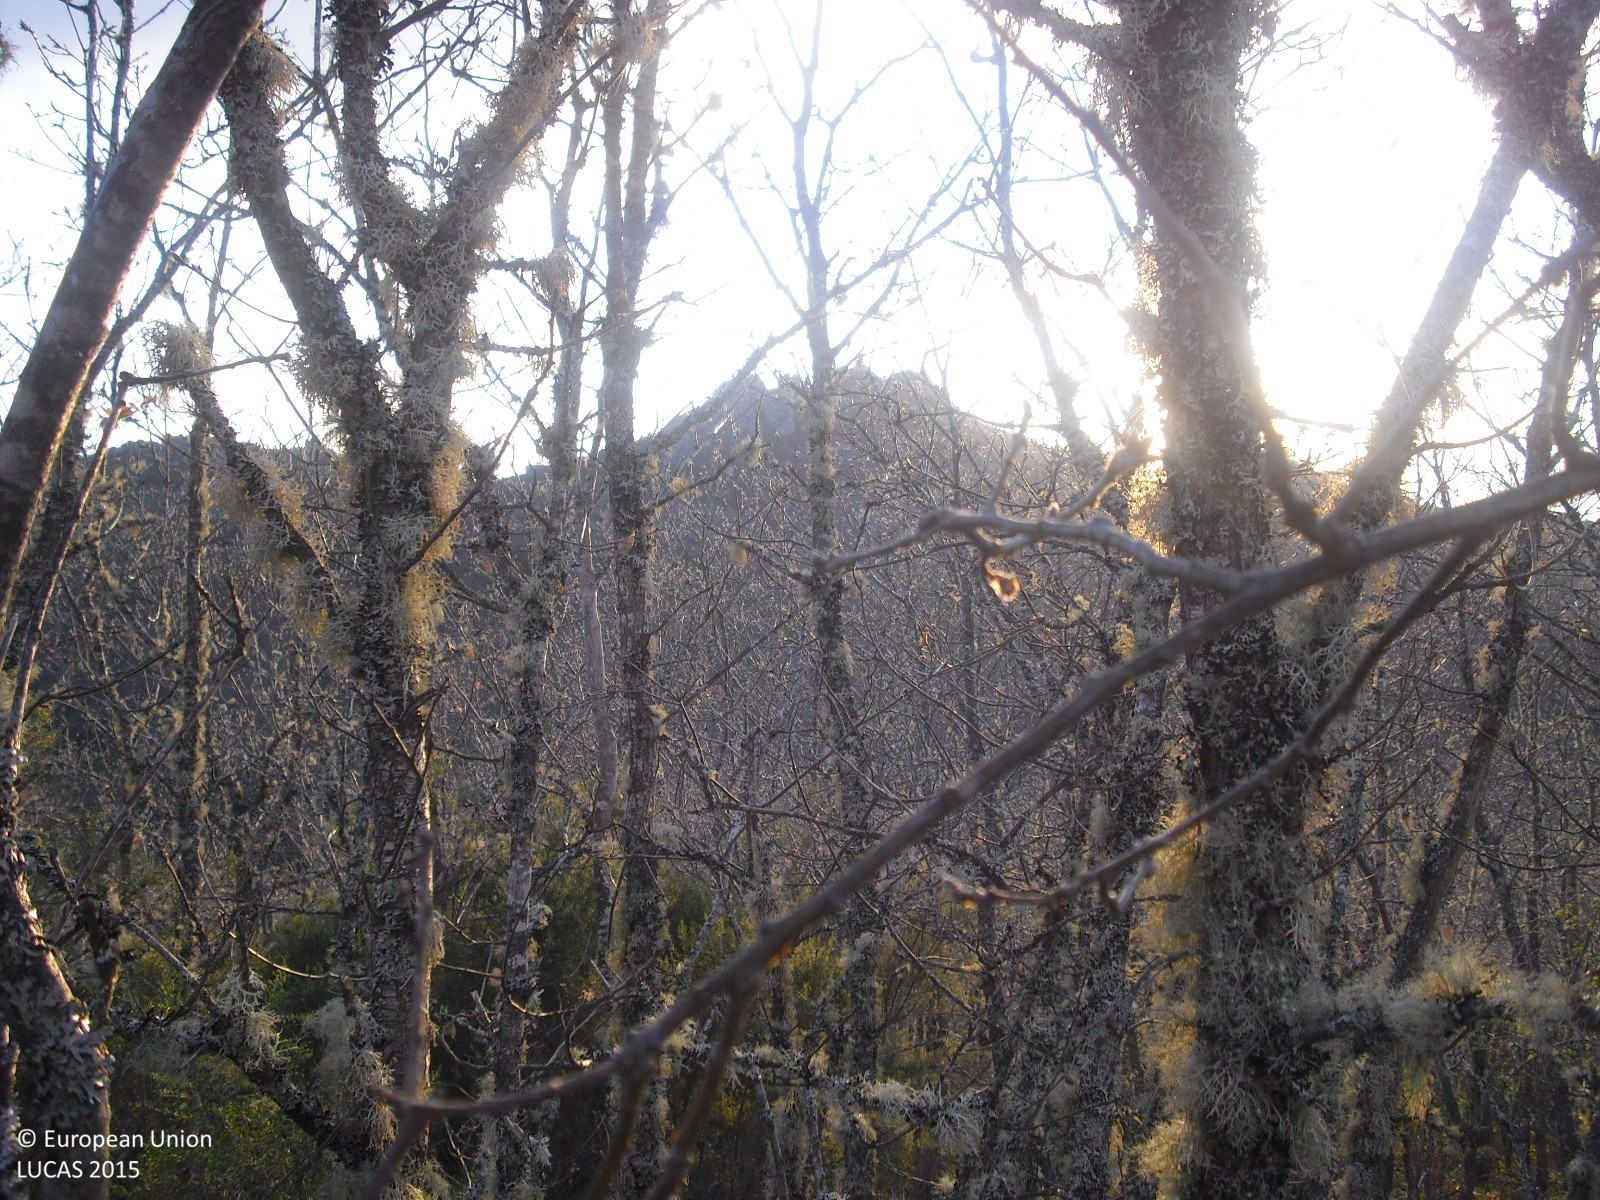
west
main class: Woodland
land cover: Broadleaved woodland
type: thermophilous deciduous forest
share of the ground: > 75 %
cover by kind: broadleaved forest trees 80 %, shrubs 10 %, herbaceous plants 5 %, consolidated bare surface 5 %
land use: Forestry
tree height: > 5 m
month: April
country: ES
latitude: 41.9628
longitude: -7.8194
